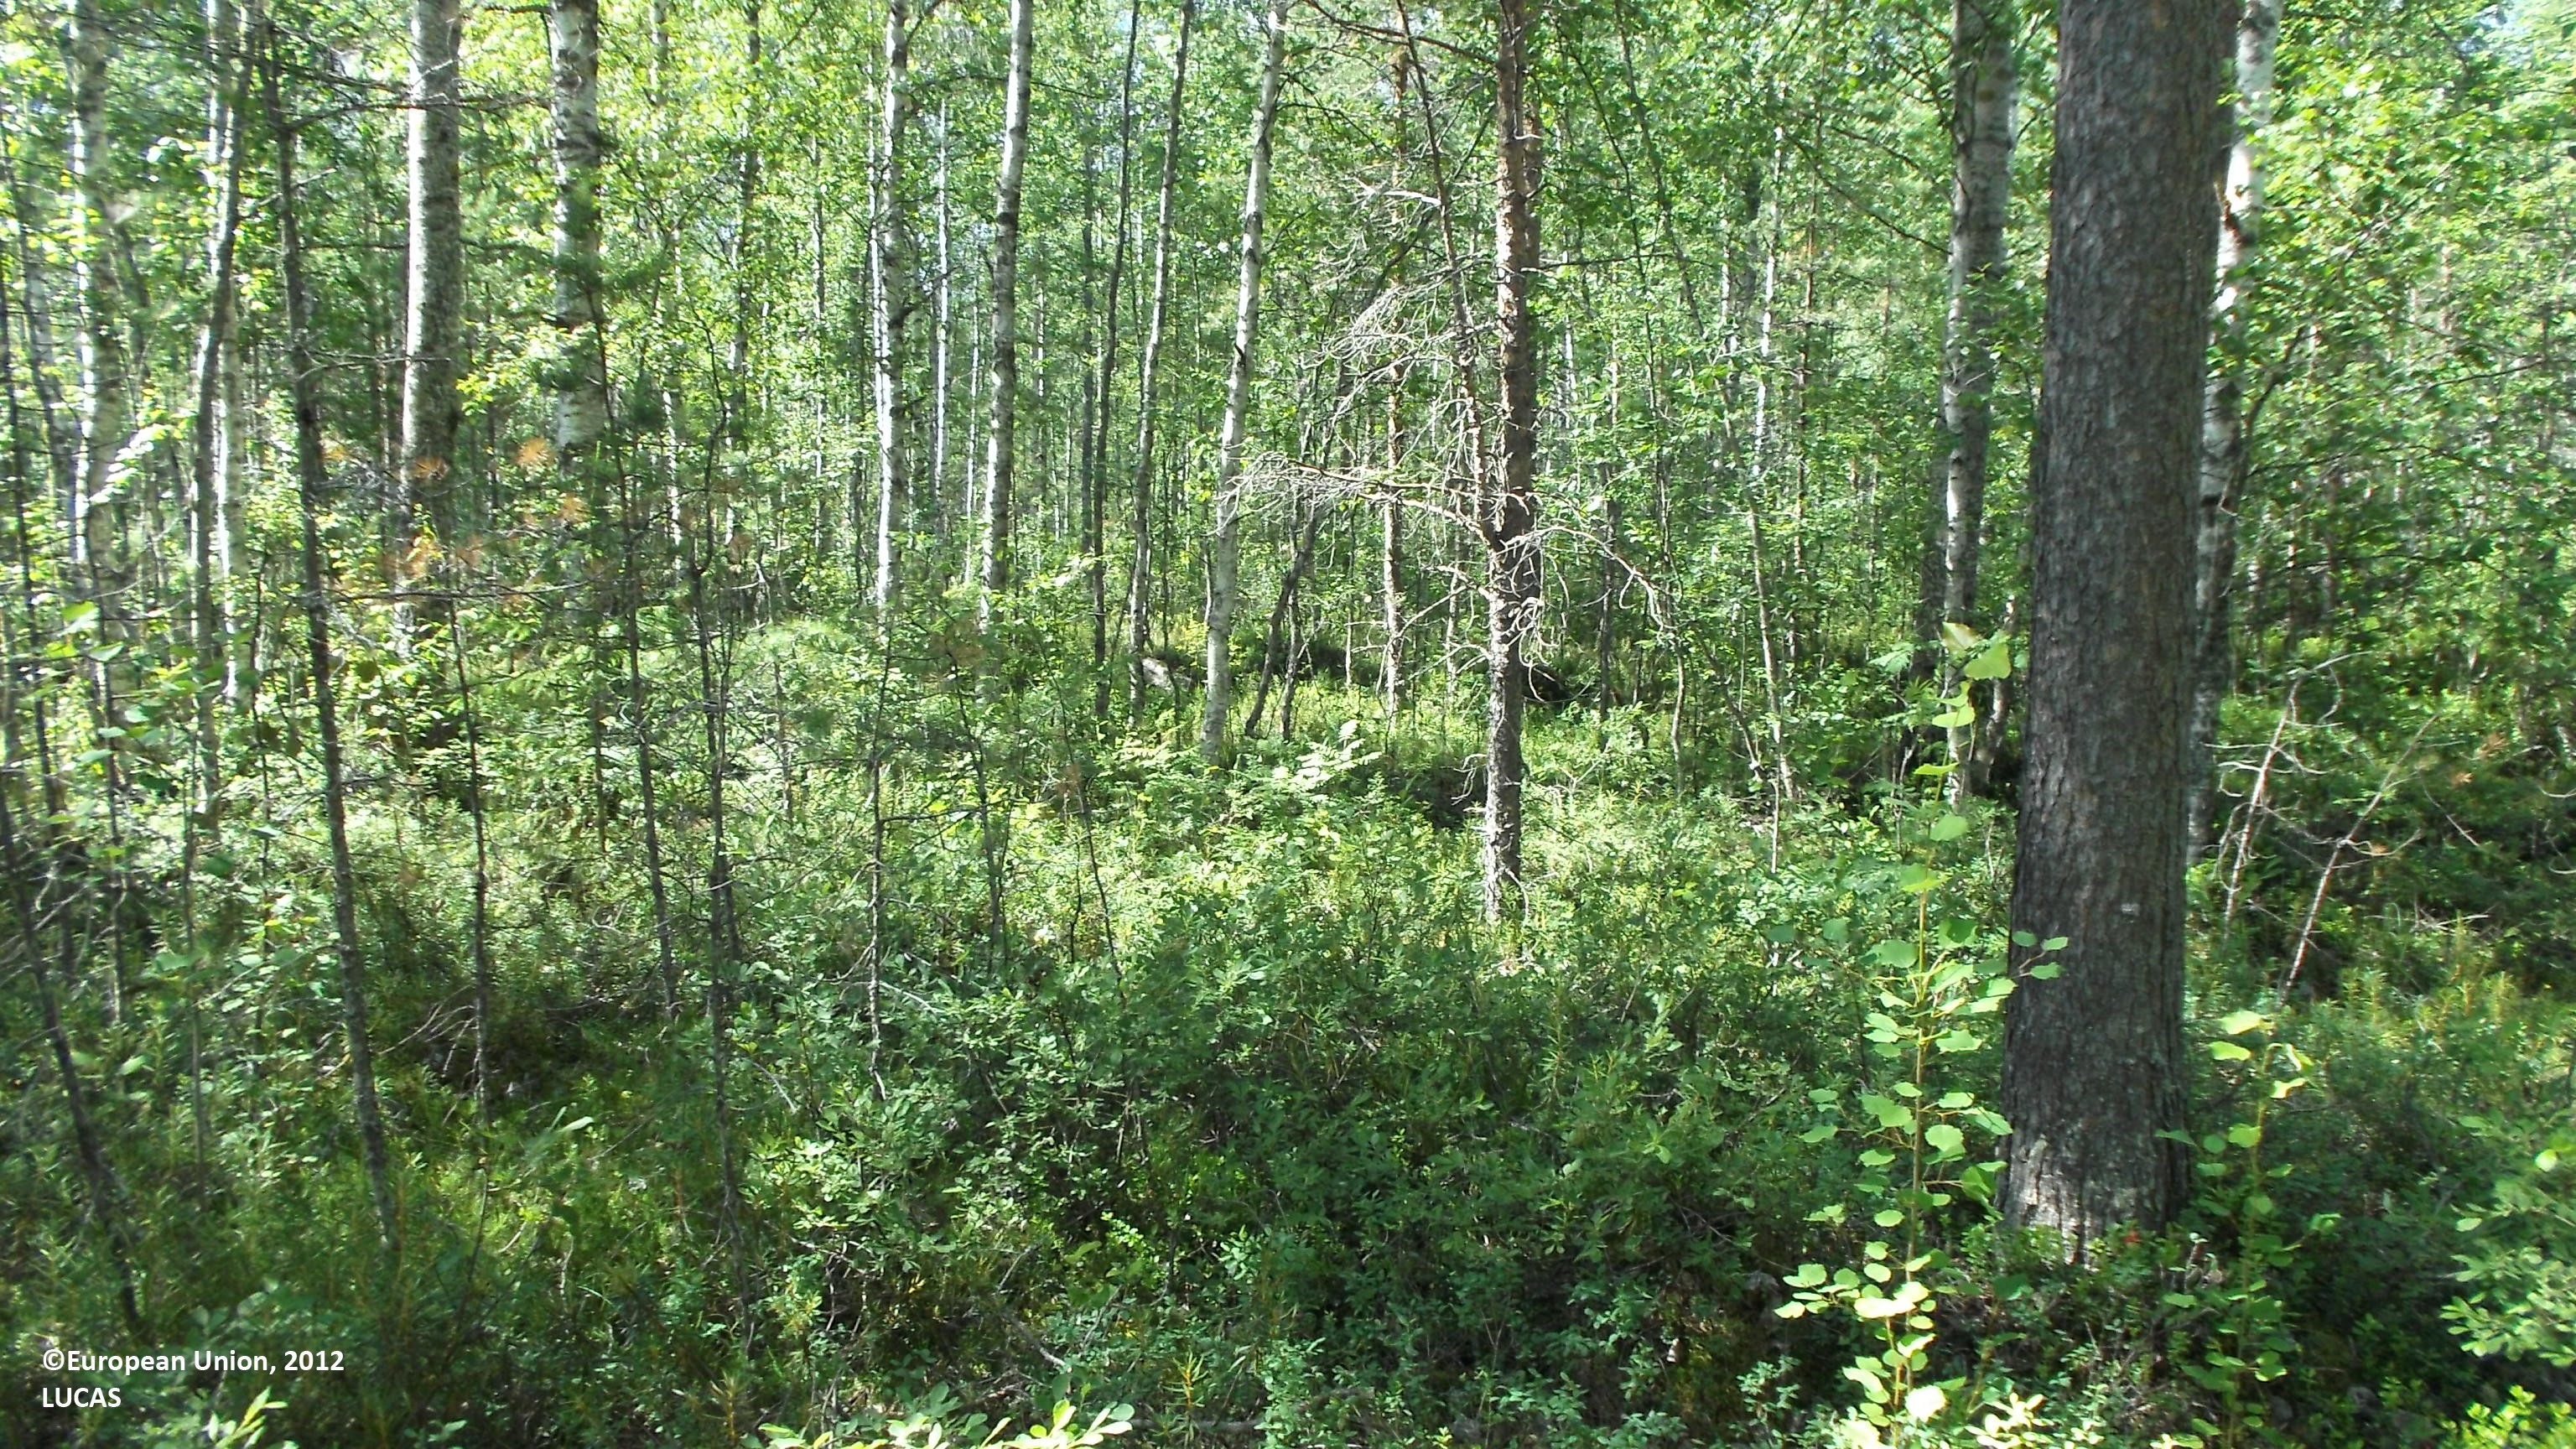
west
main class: Woodland
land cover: Pine dominated mixed woodland
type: boreal forest
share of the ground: 25 - 50 %
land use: Forestry
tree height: > 5 m
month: July
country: FI
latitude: 63.6149
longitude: 23.9240
